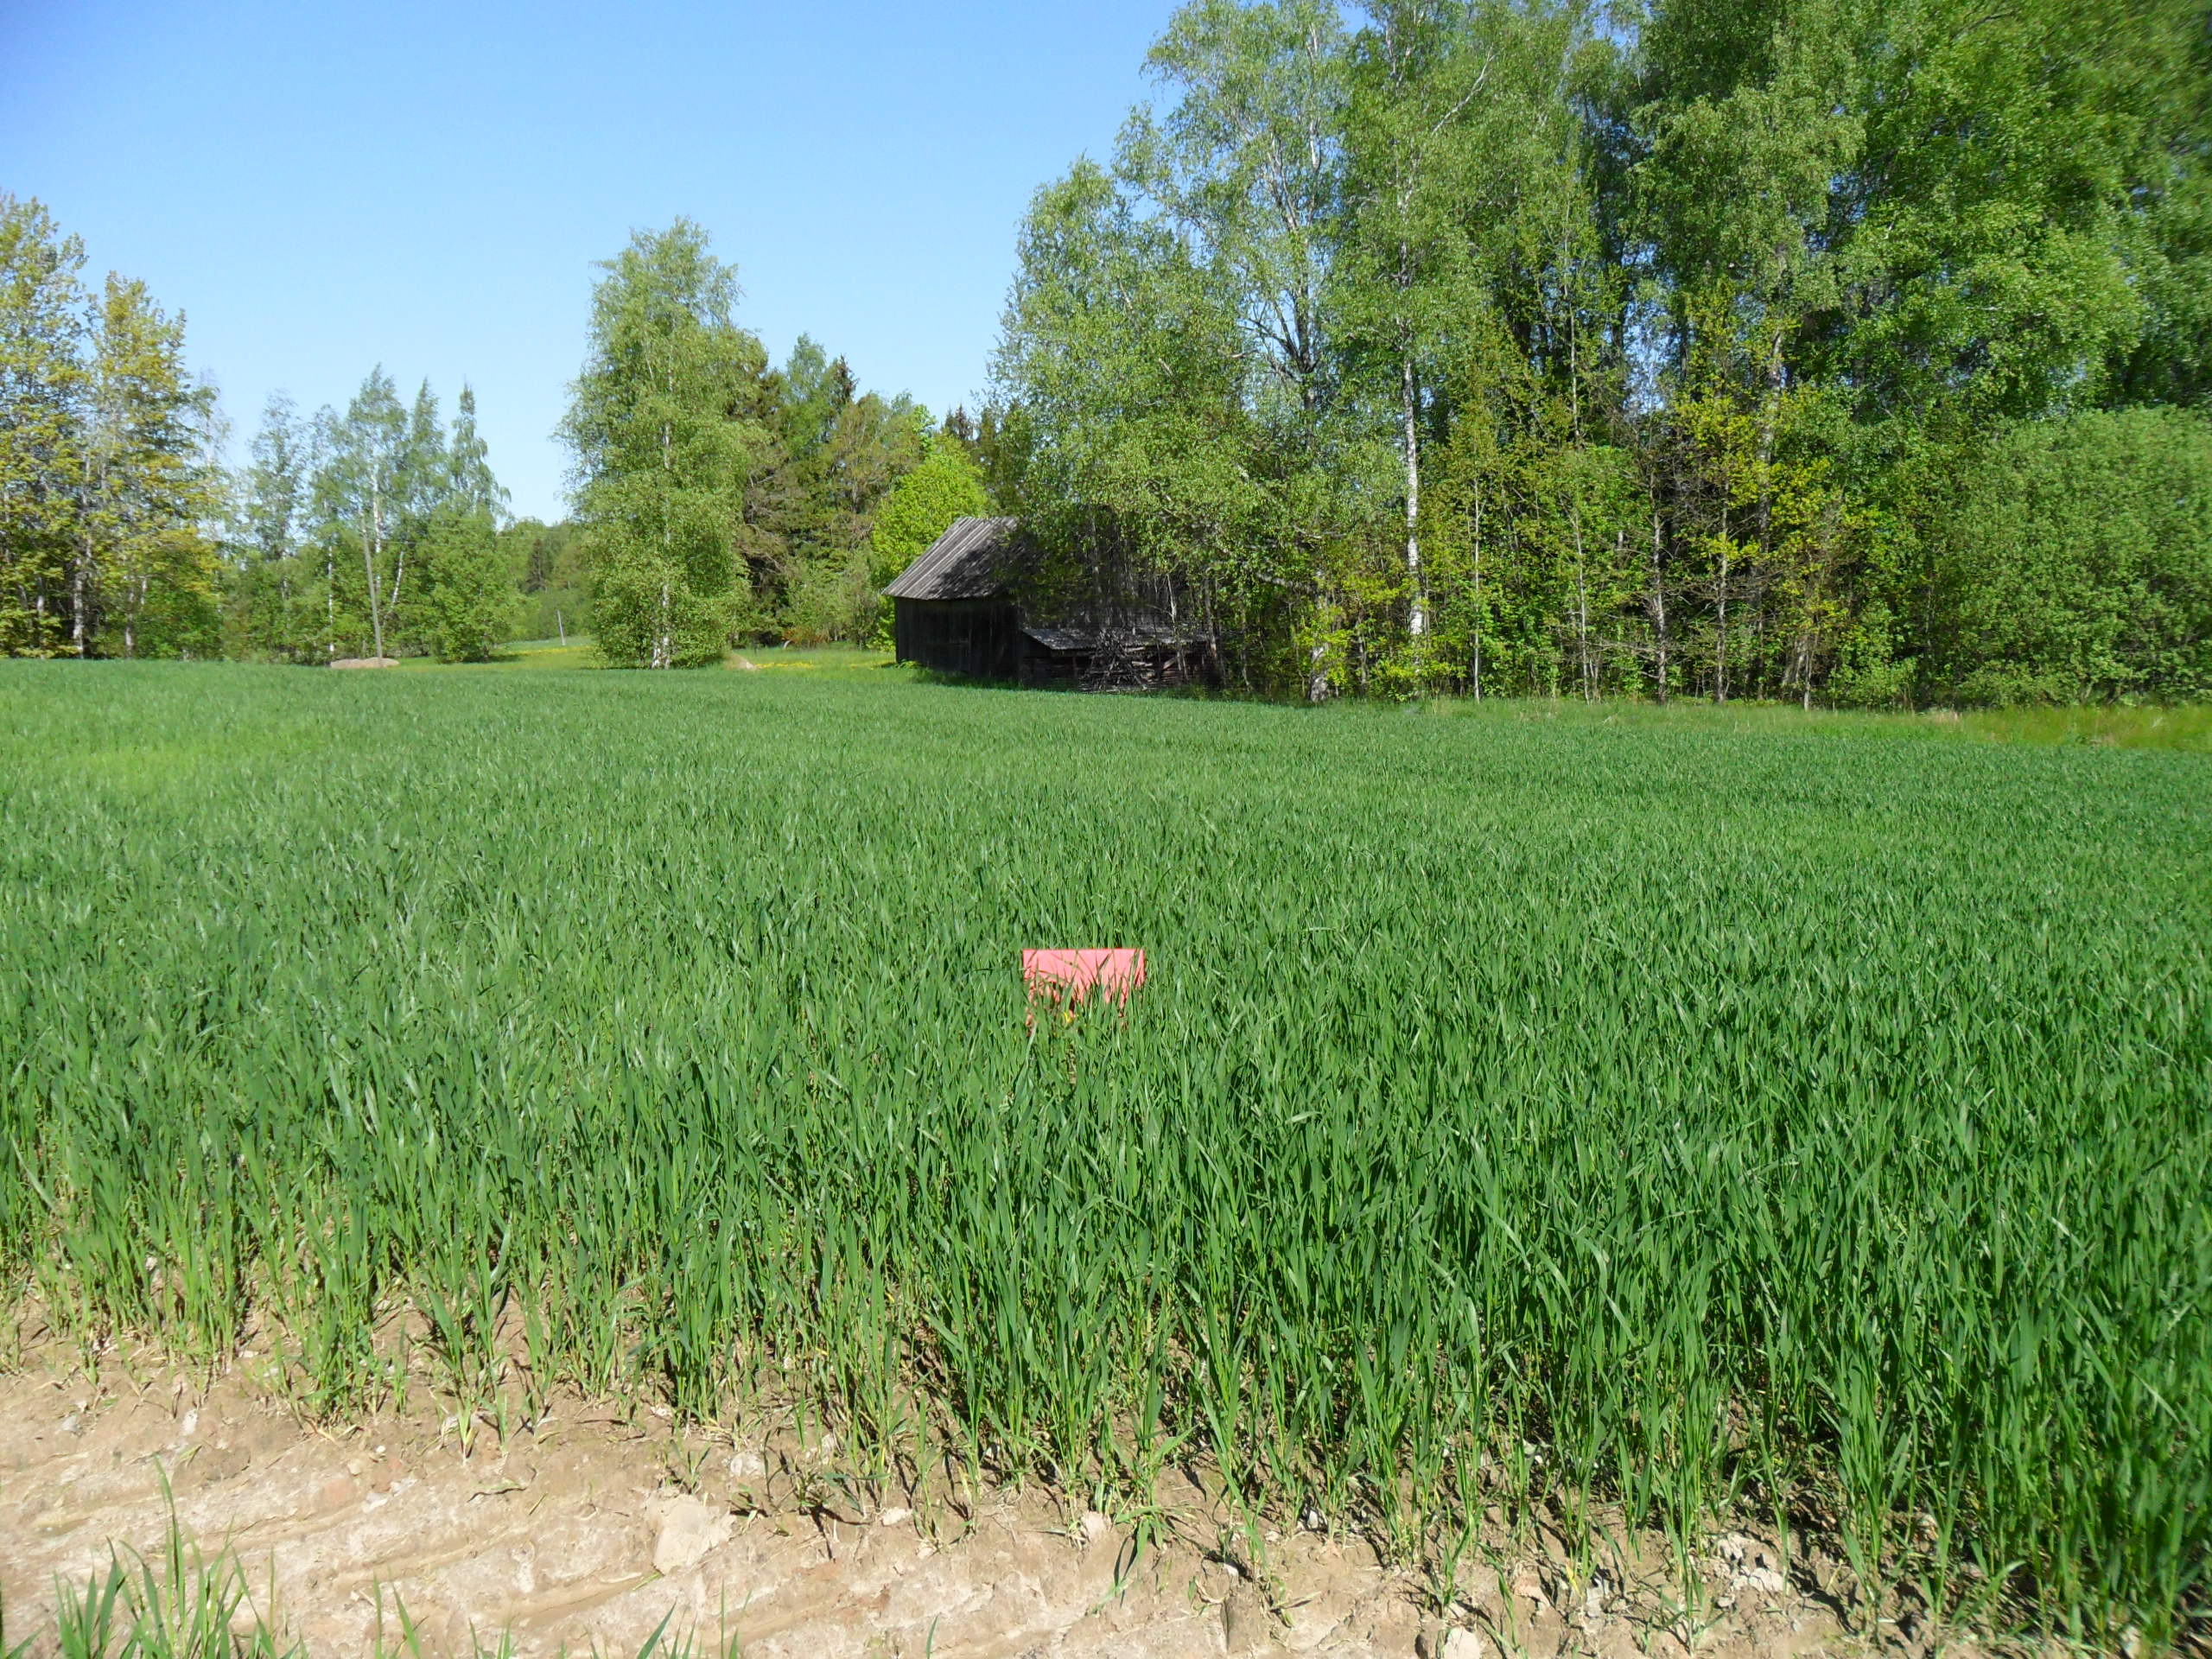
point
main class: Cropland
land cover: Barley
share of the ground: > 75 %
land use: Agriculture (excluding fallow land and kitchen gardens)
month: May
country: LV
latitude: 57.2293
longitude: 22.5277
